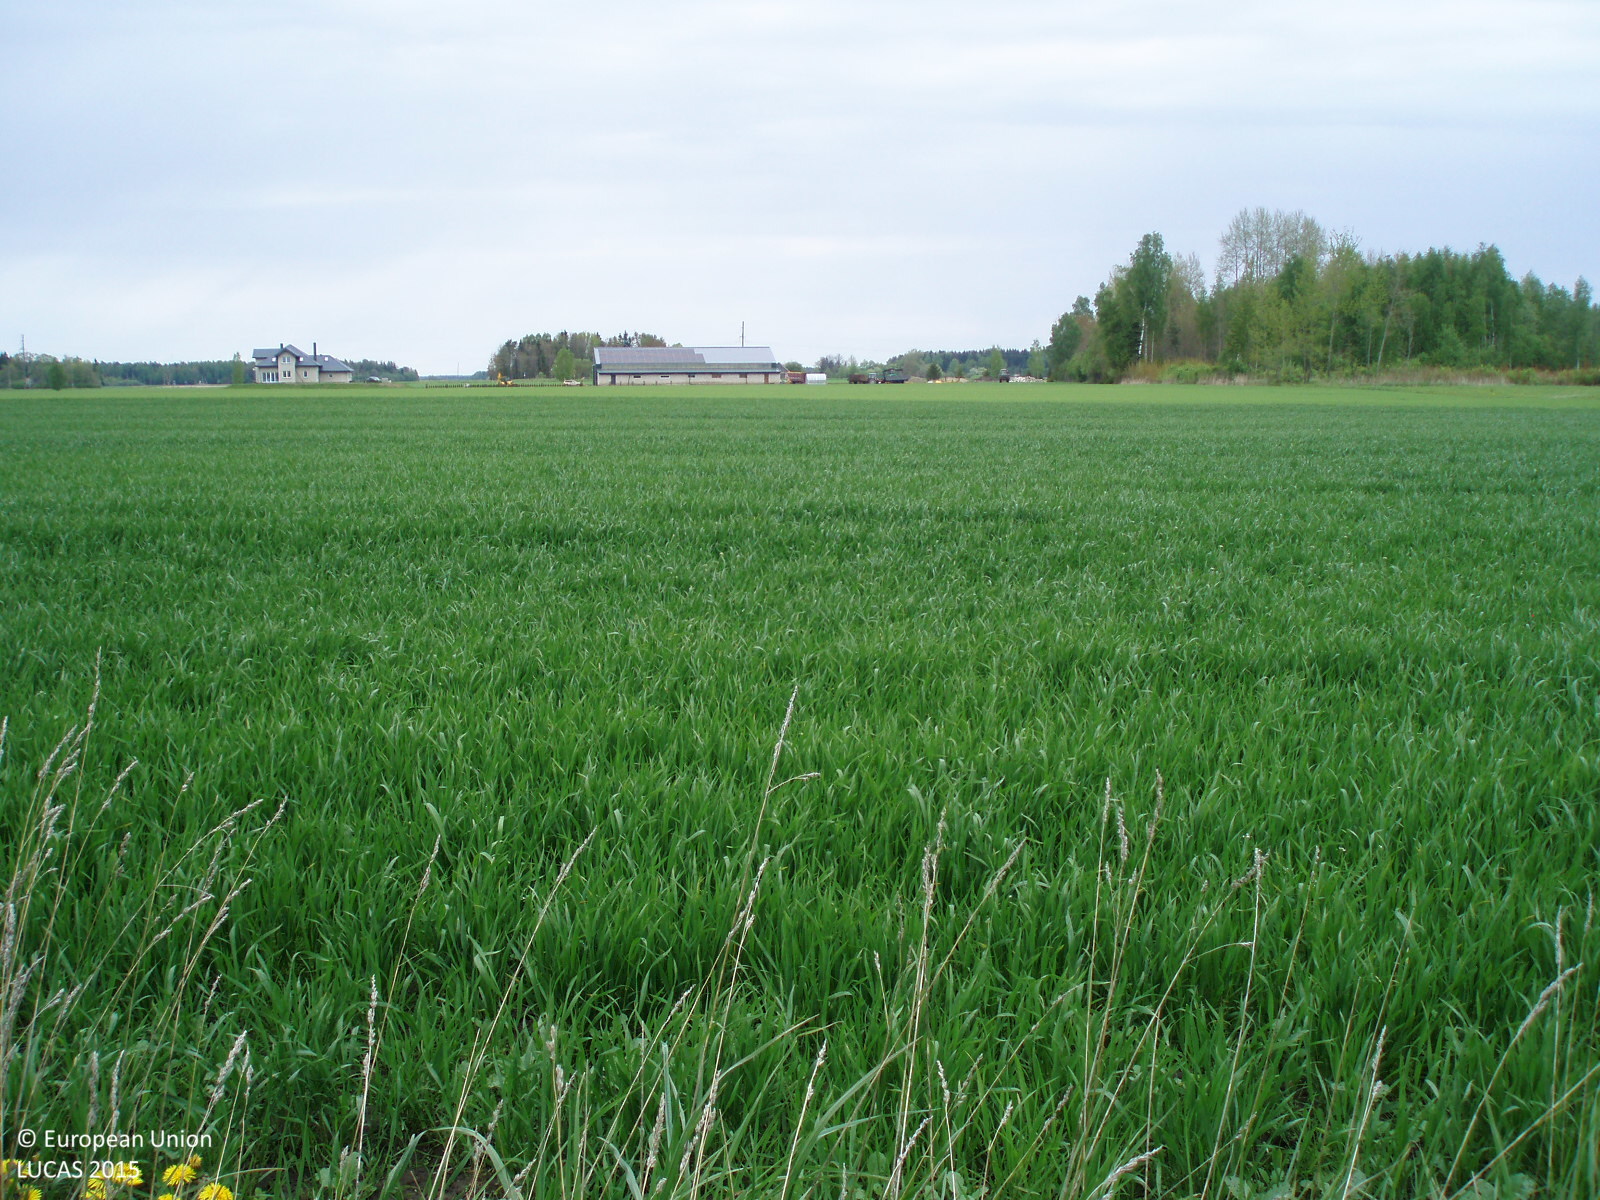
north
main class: Grassland
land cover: Grassland without tree/shrub cover
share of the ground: > 75 %
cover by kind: herbaceous plants 100 %
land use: Agriculture (excluding fallow land and kitchen gardens)
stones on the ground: < 10 %
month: May
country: LT
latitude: 56.3483
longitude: 22.4022
